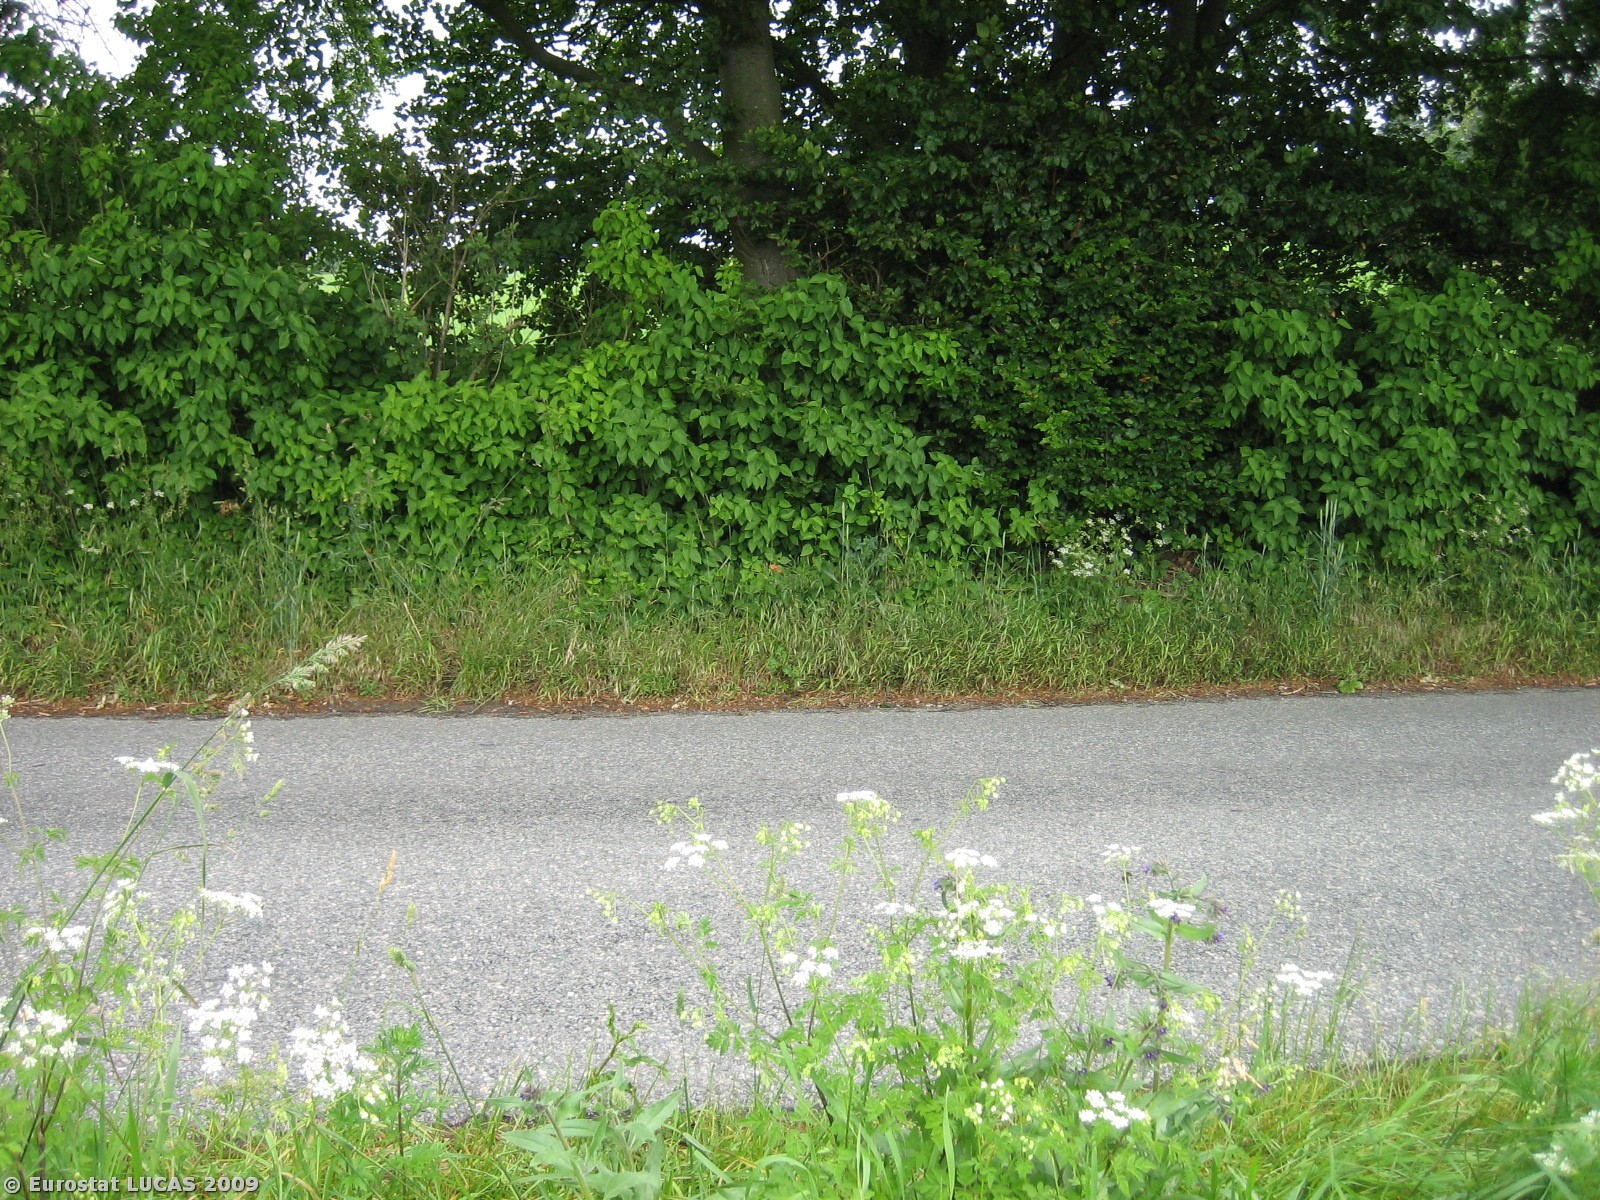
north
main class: Cropland
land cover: Barley
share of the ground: > 75 %
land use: Agriculture (excluding fallow land and kitchen gardens)
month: June
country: DK
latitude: 56.2056
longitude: 10.1449
